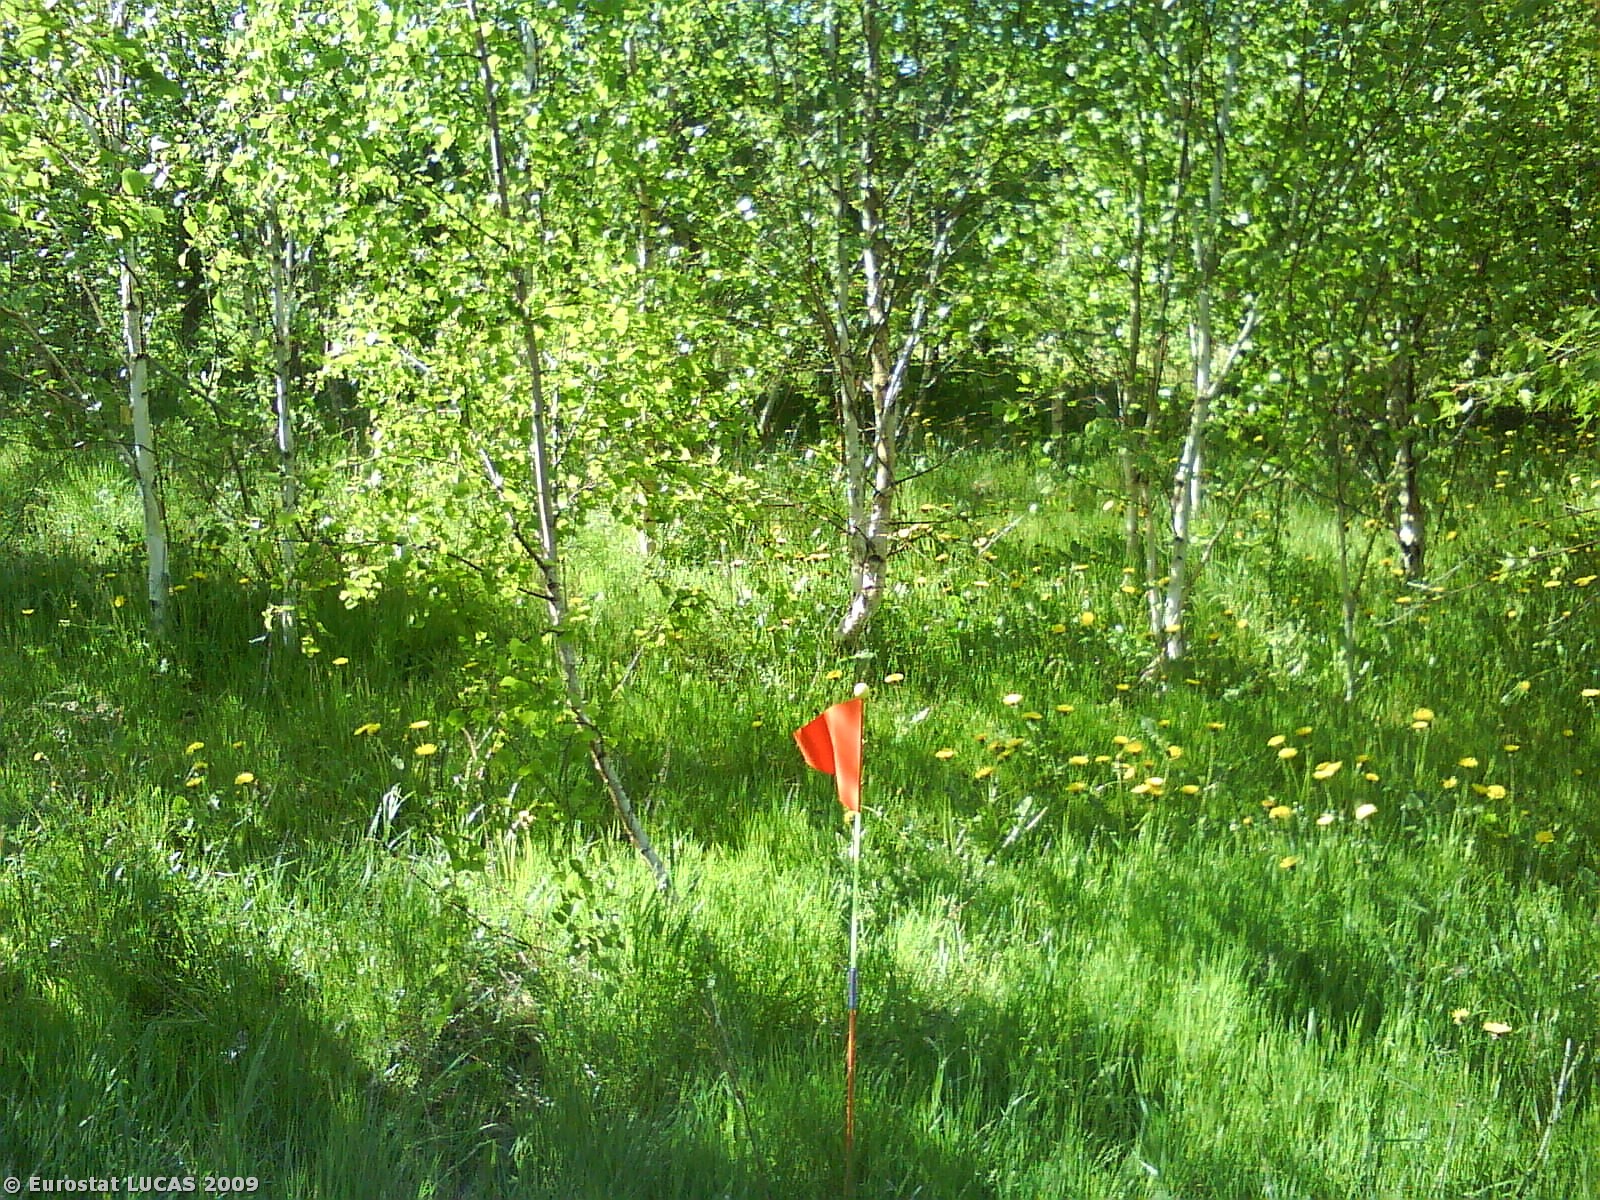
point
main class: Woodland
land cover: Broadleaved woodland
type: plantations and self-sown exotic forest
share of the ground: 25 - 50 %
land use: Unused
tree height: > 5 m
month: May
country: DK
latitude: 56.3473
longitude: 10.7595
